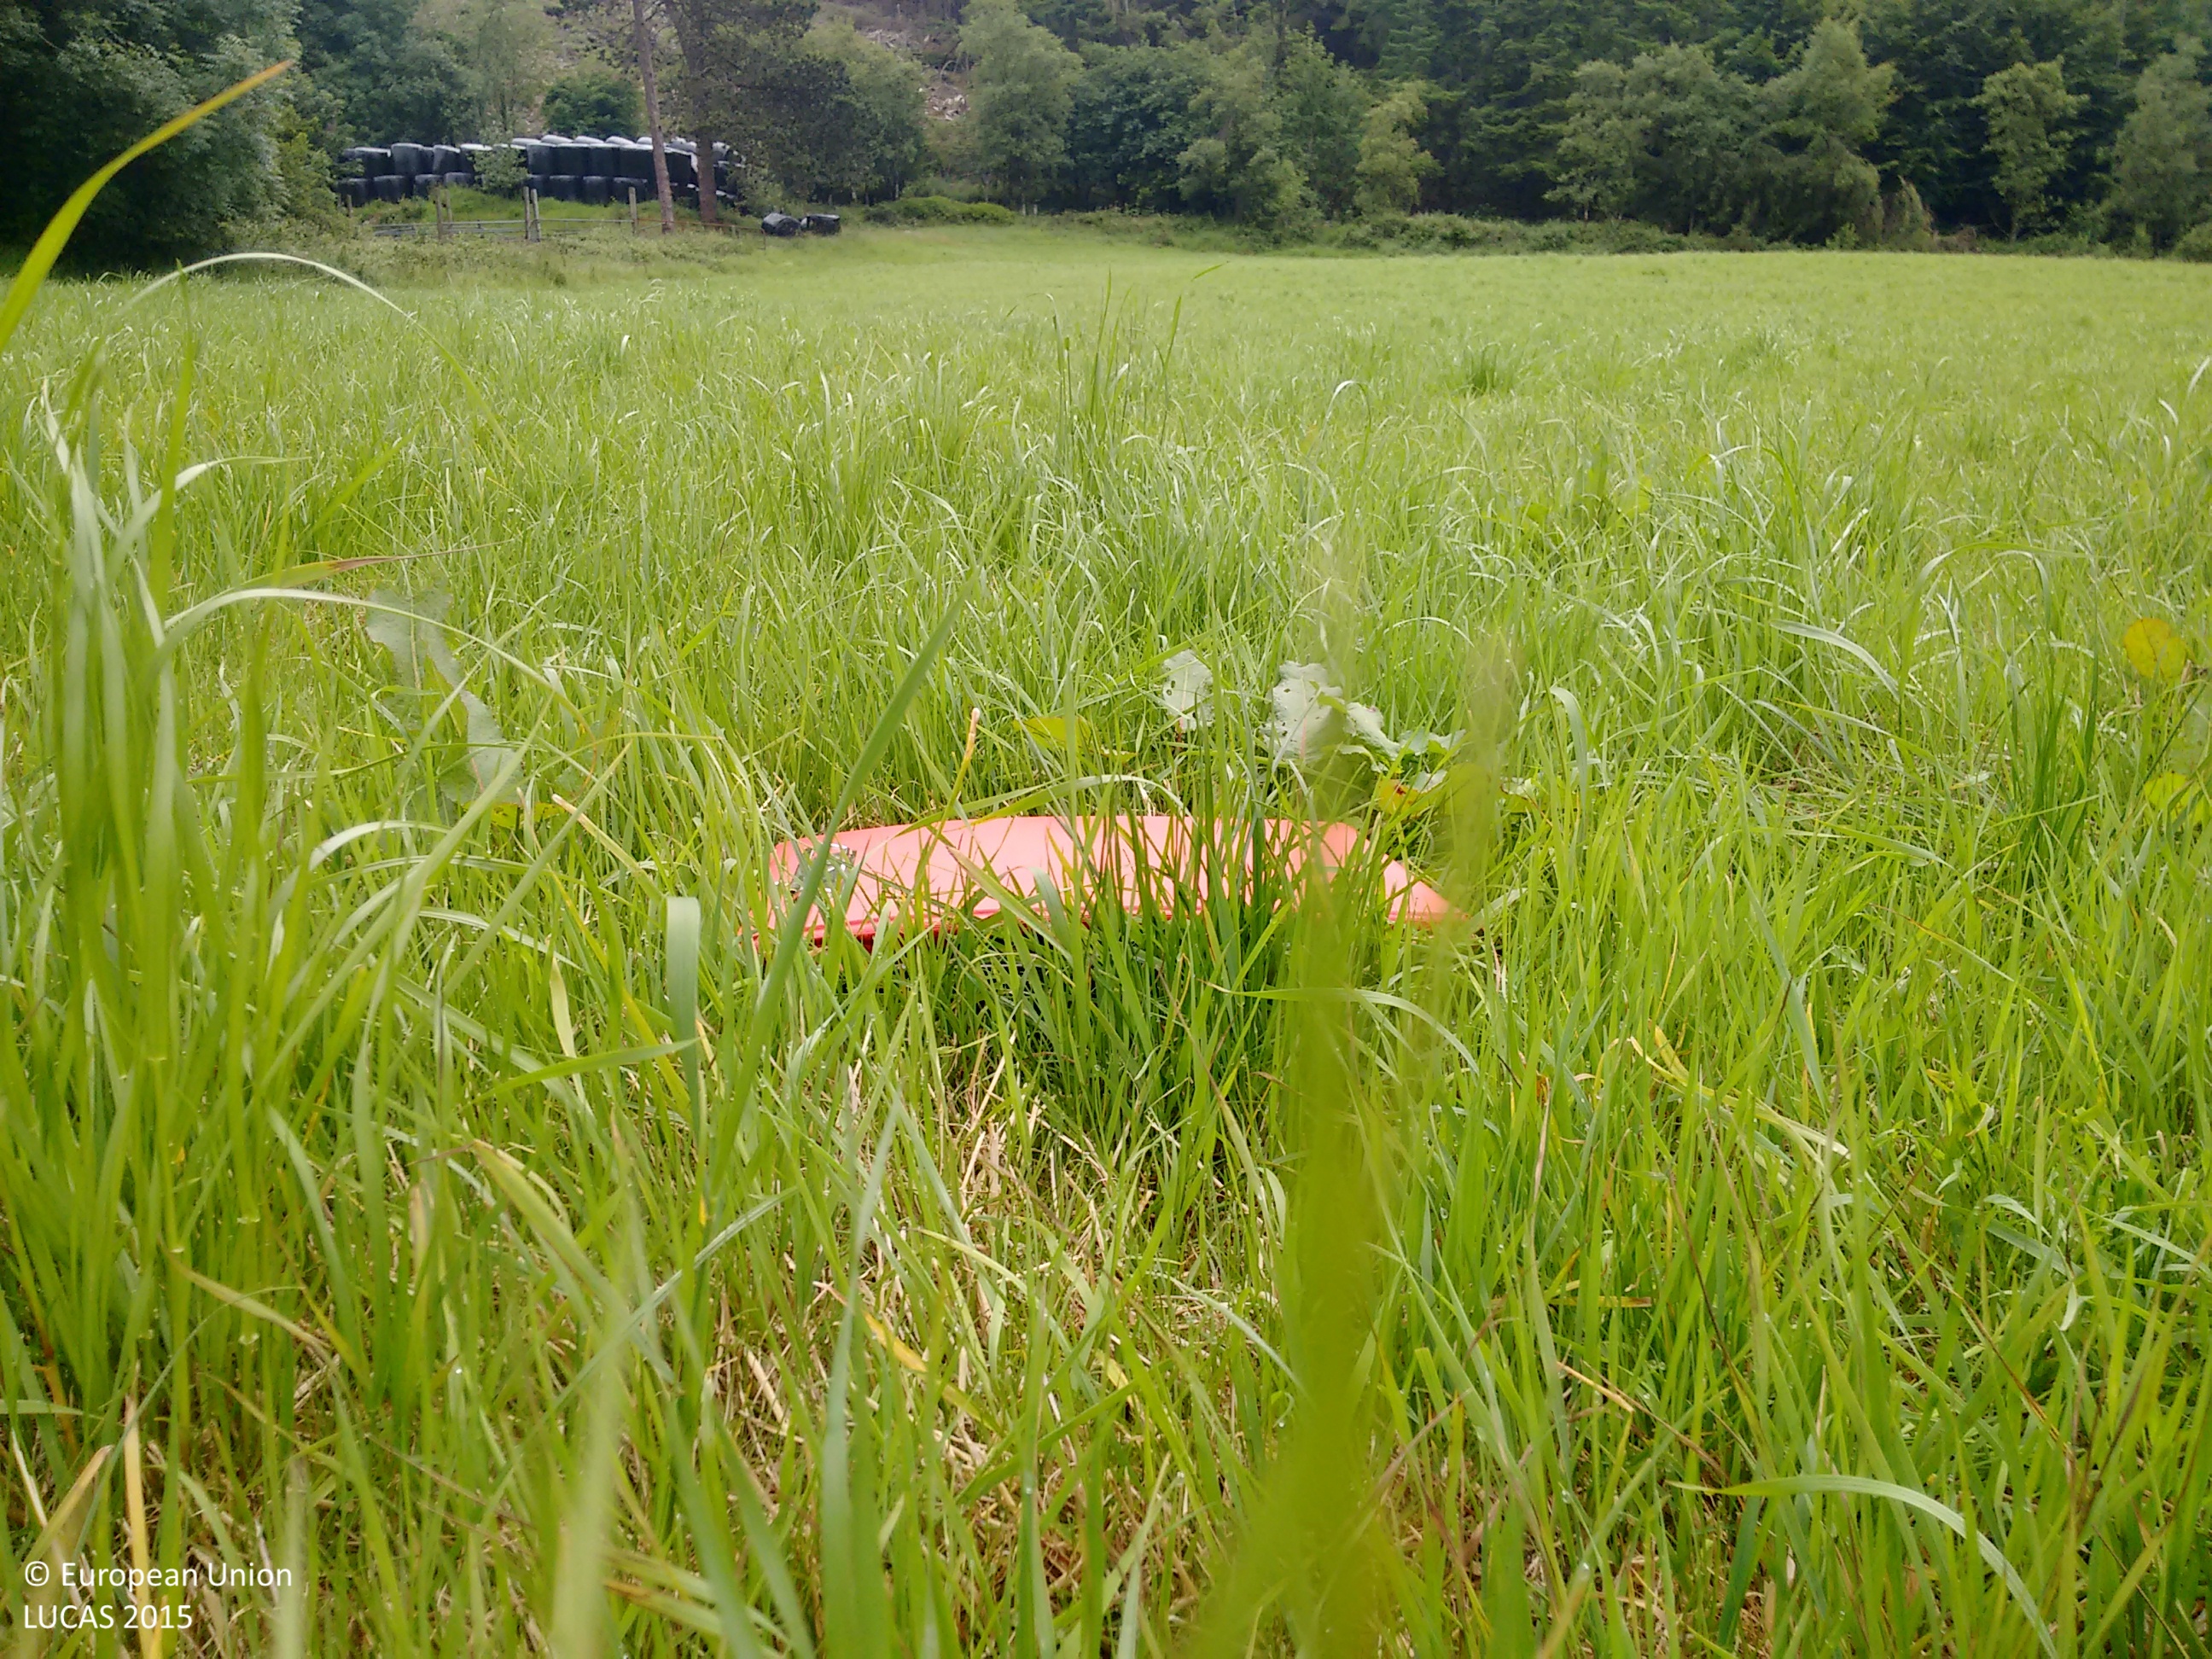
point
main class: Grassland
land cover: Grassland without tree/shrub cover
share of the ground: > 75 %
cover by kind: herbaceous plants 100 %
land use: Agriculture (excluding fallow land and kitchen gardens)
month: July
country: IE
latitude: 52.3328
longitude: -8.4632
